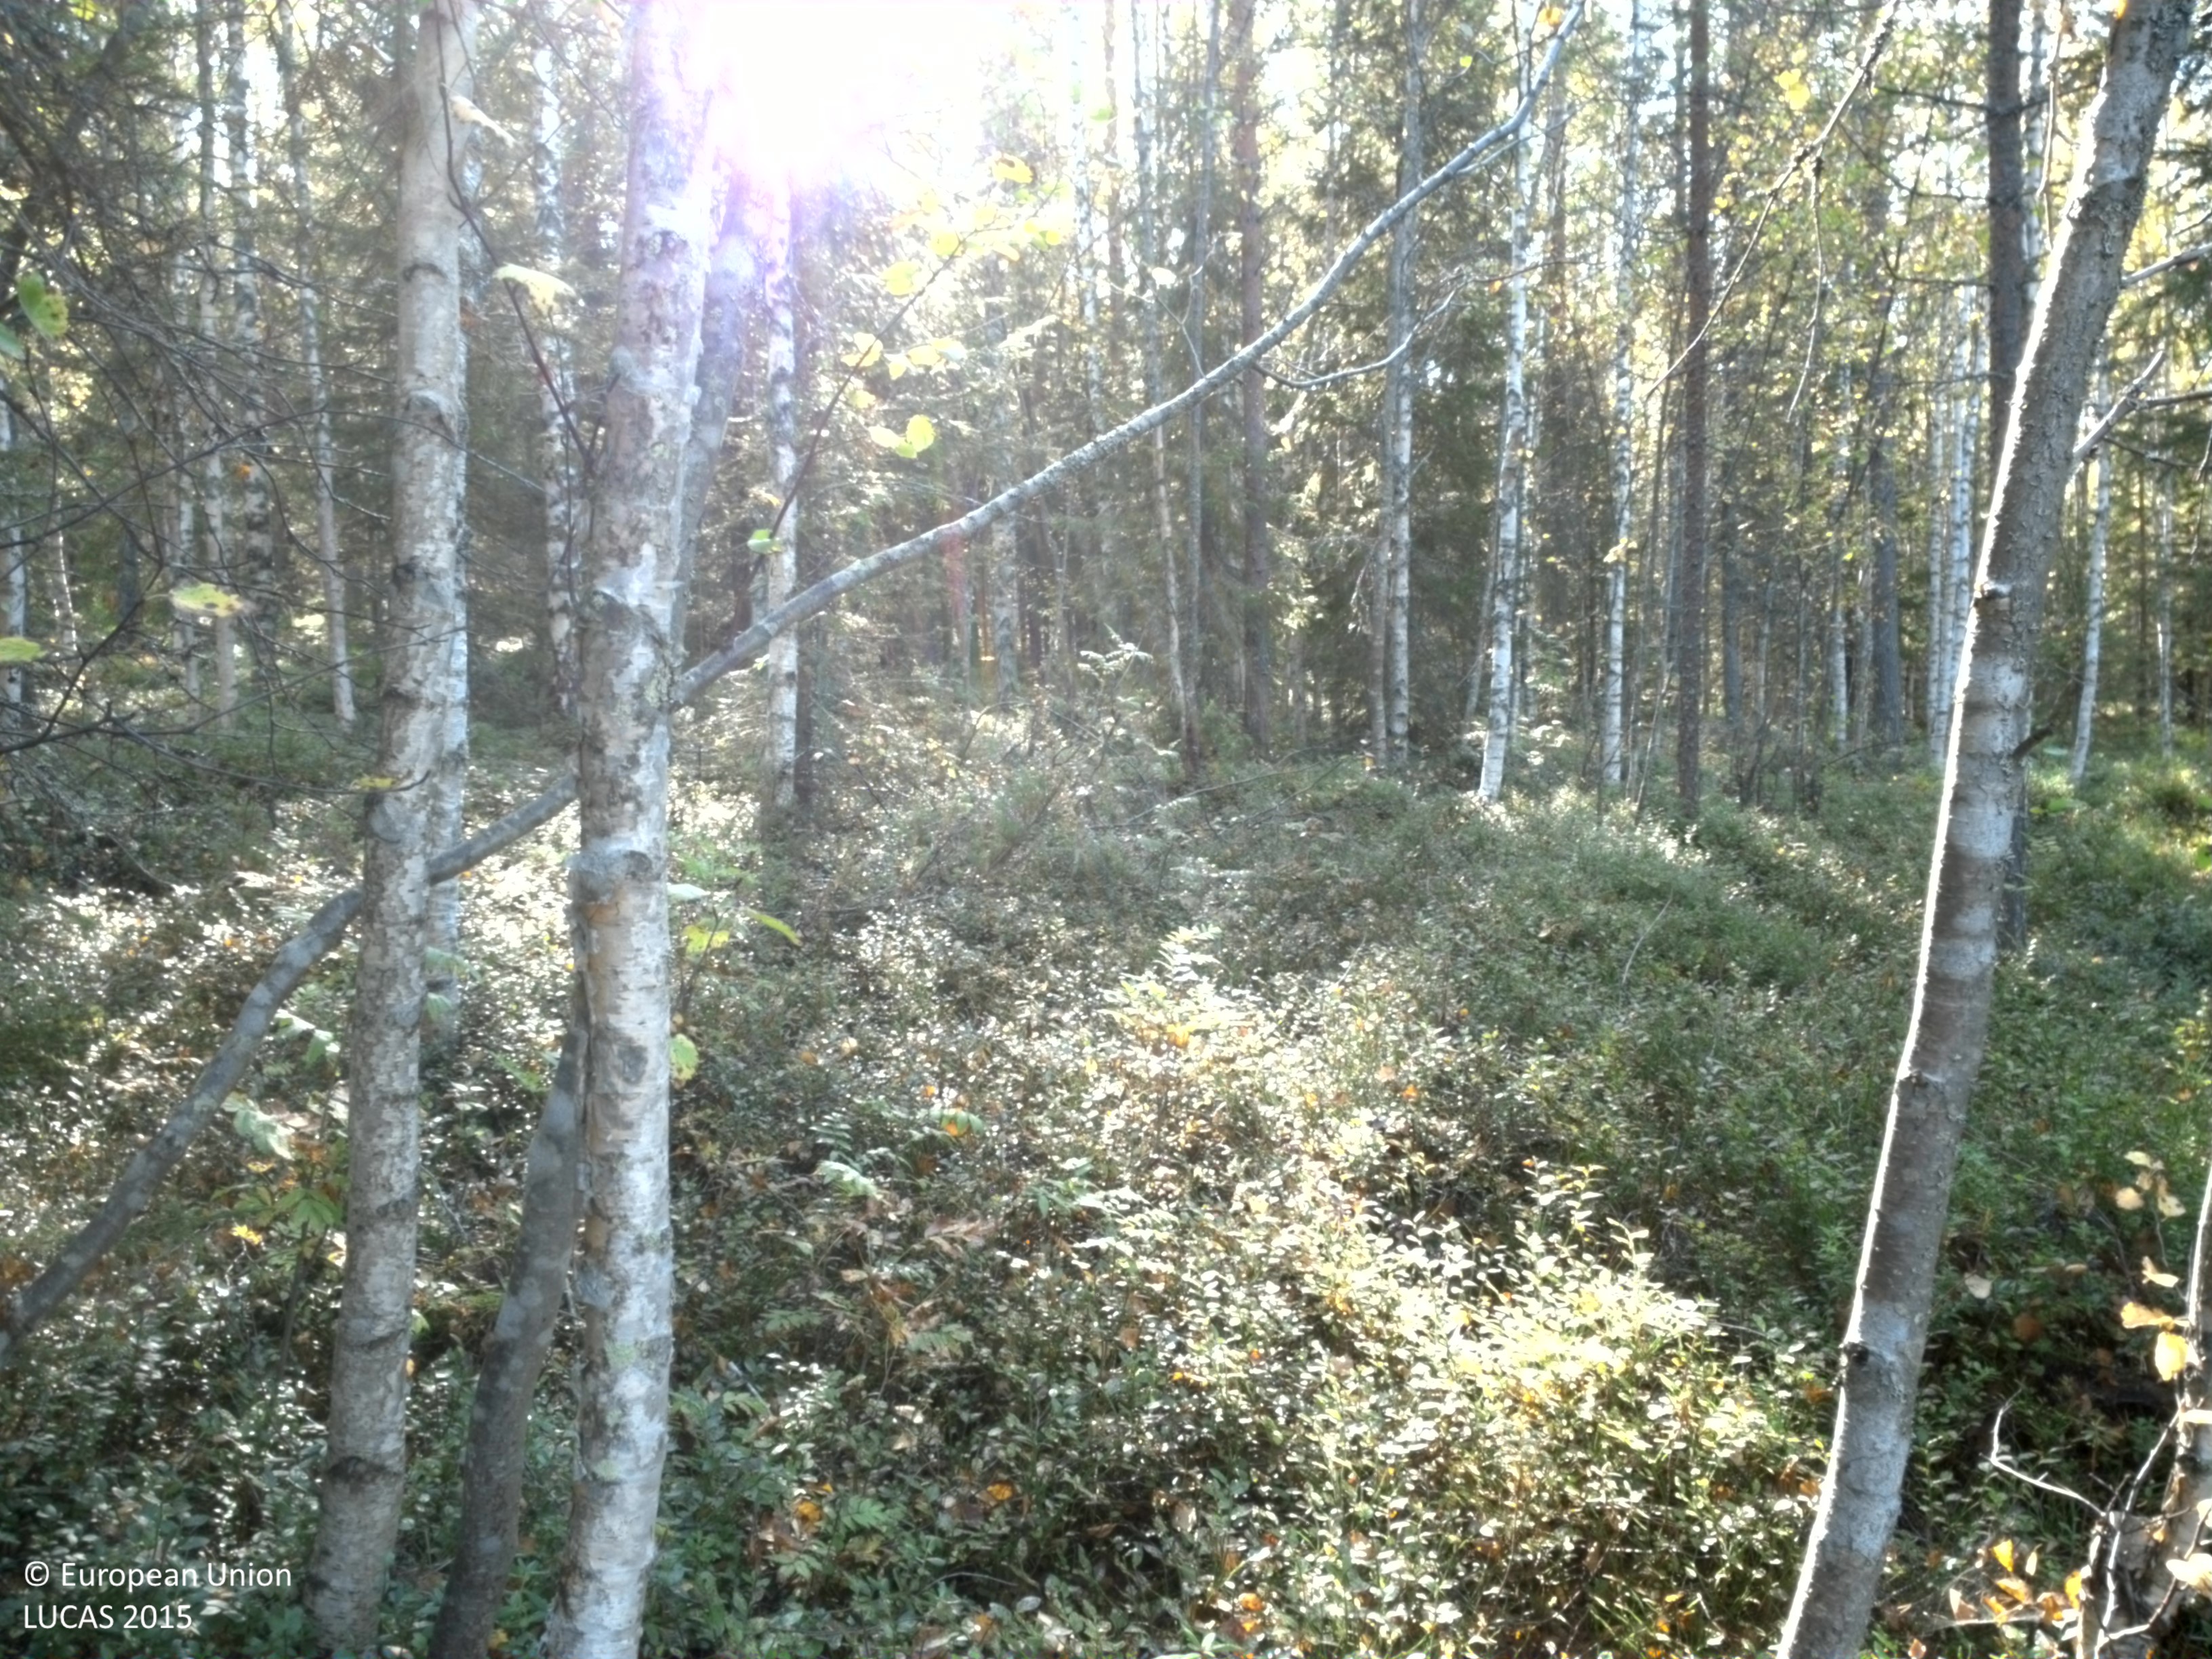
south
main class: Woodland
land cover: Spruce dominated mixed woodland
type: boreal forest
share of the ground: 25 - 50 %
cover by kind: shrubs 50 %, coniferous forest trees 25 %, broadleaved forest trees 25 %
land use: Forestry
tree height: > 5 m
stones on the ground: < 10 %
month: September
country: SE
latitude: 65.8235
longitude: 22.5634
